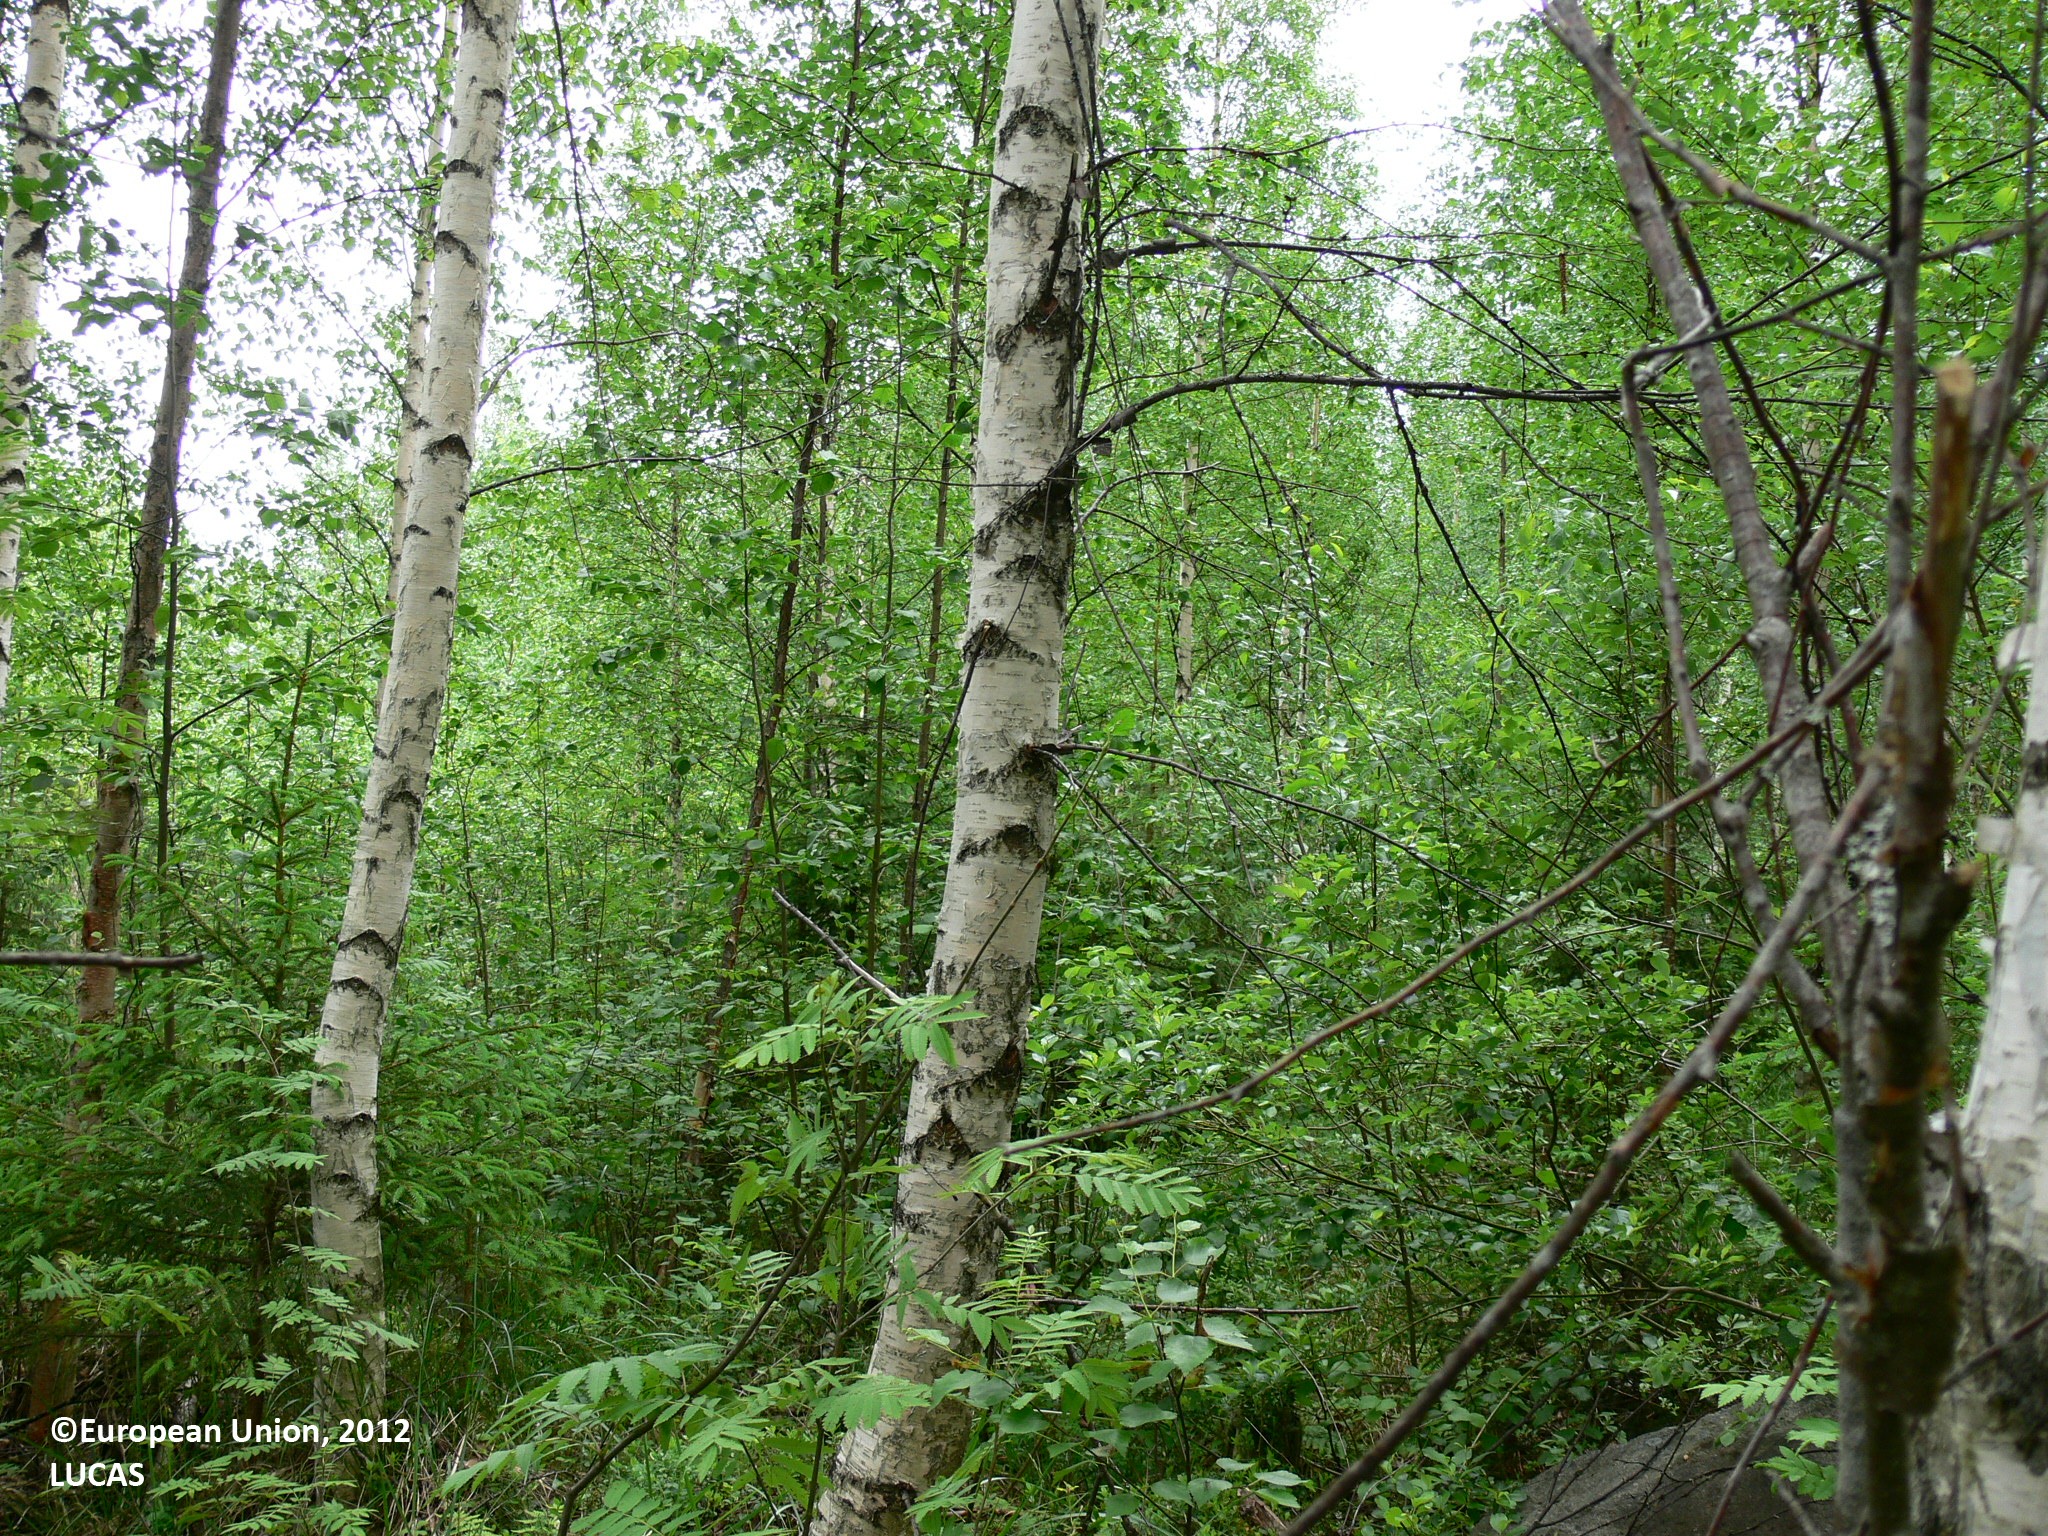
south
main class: Woodland
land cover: Broadleaved woodland
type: boreal forest
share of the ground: > 75 %
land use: Forestry
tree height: > 5 m
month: June
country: FI
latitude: 62.7957
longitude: 30.4522
